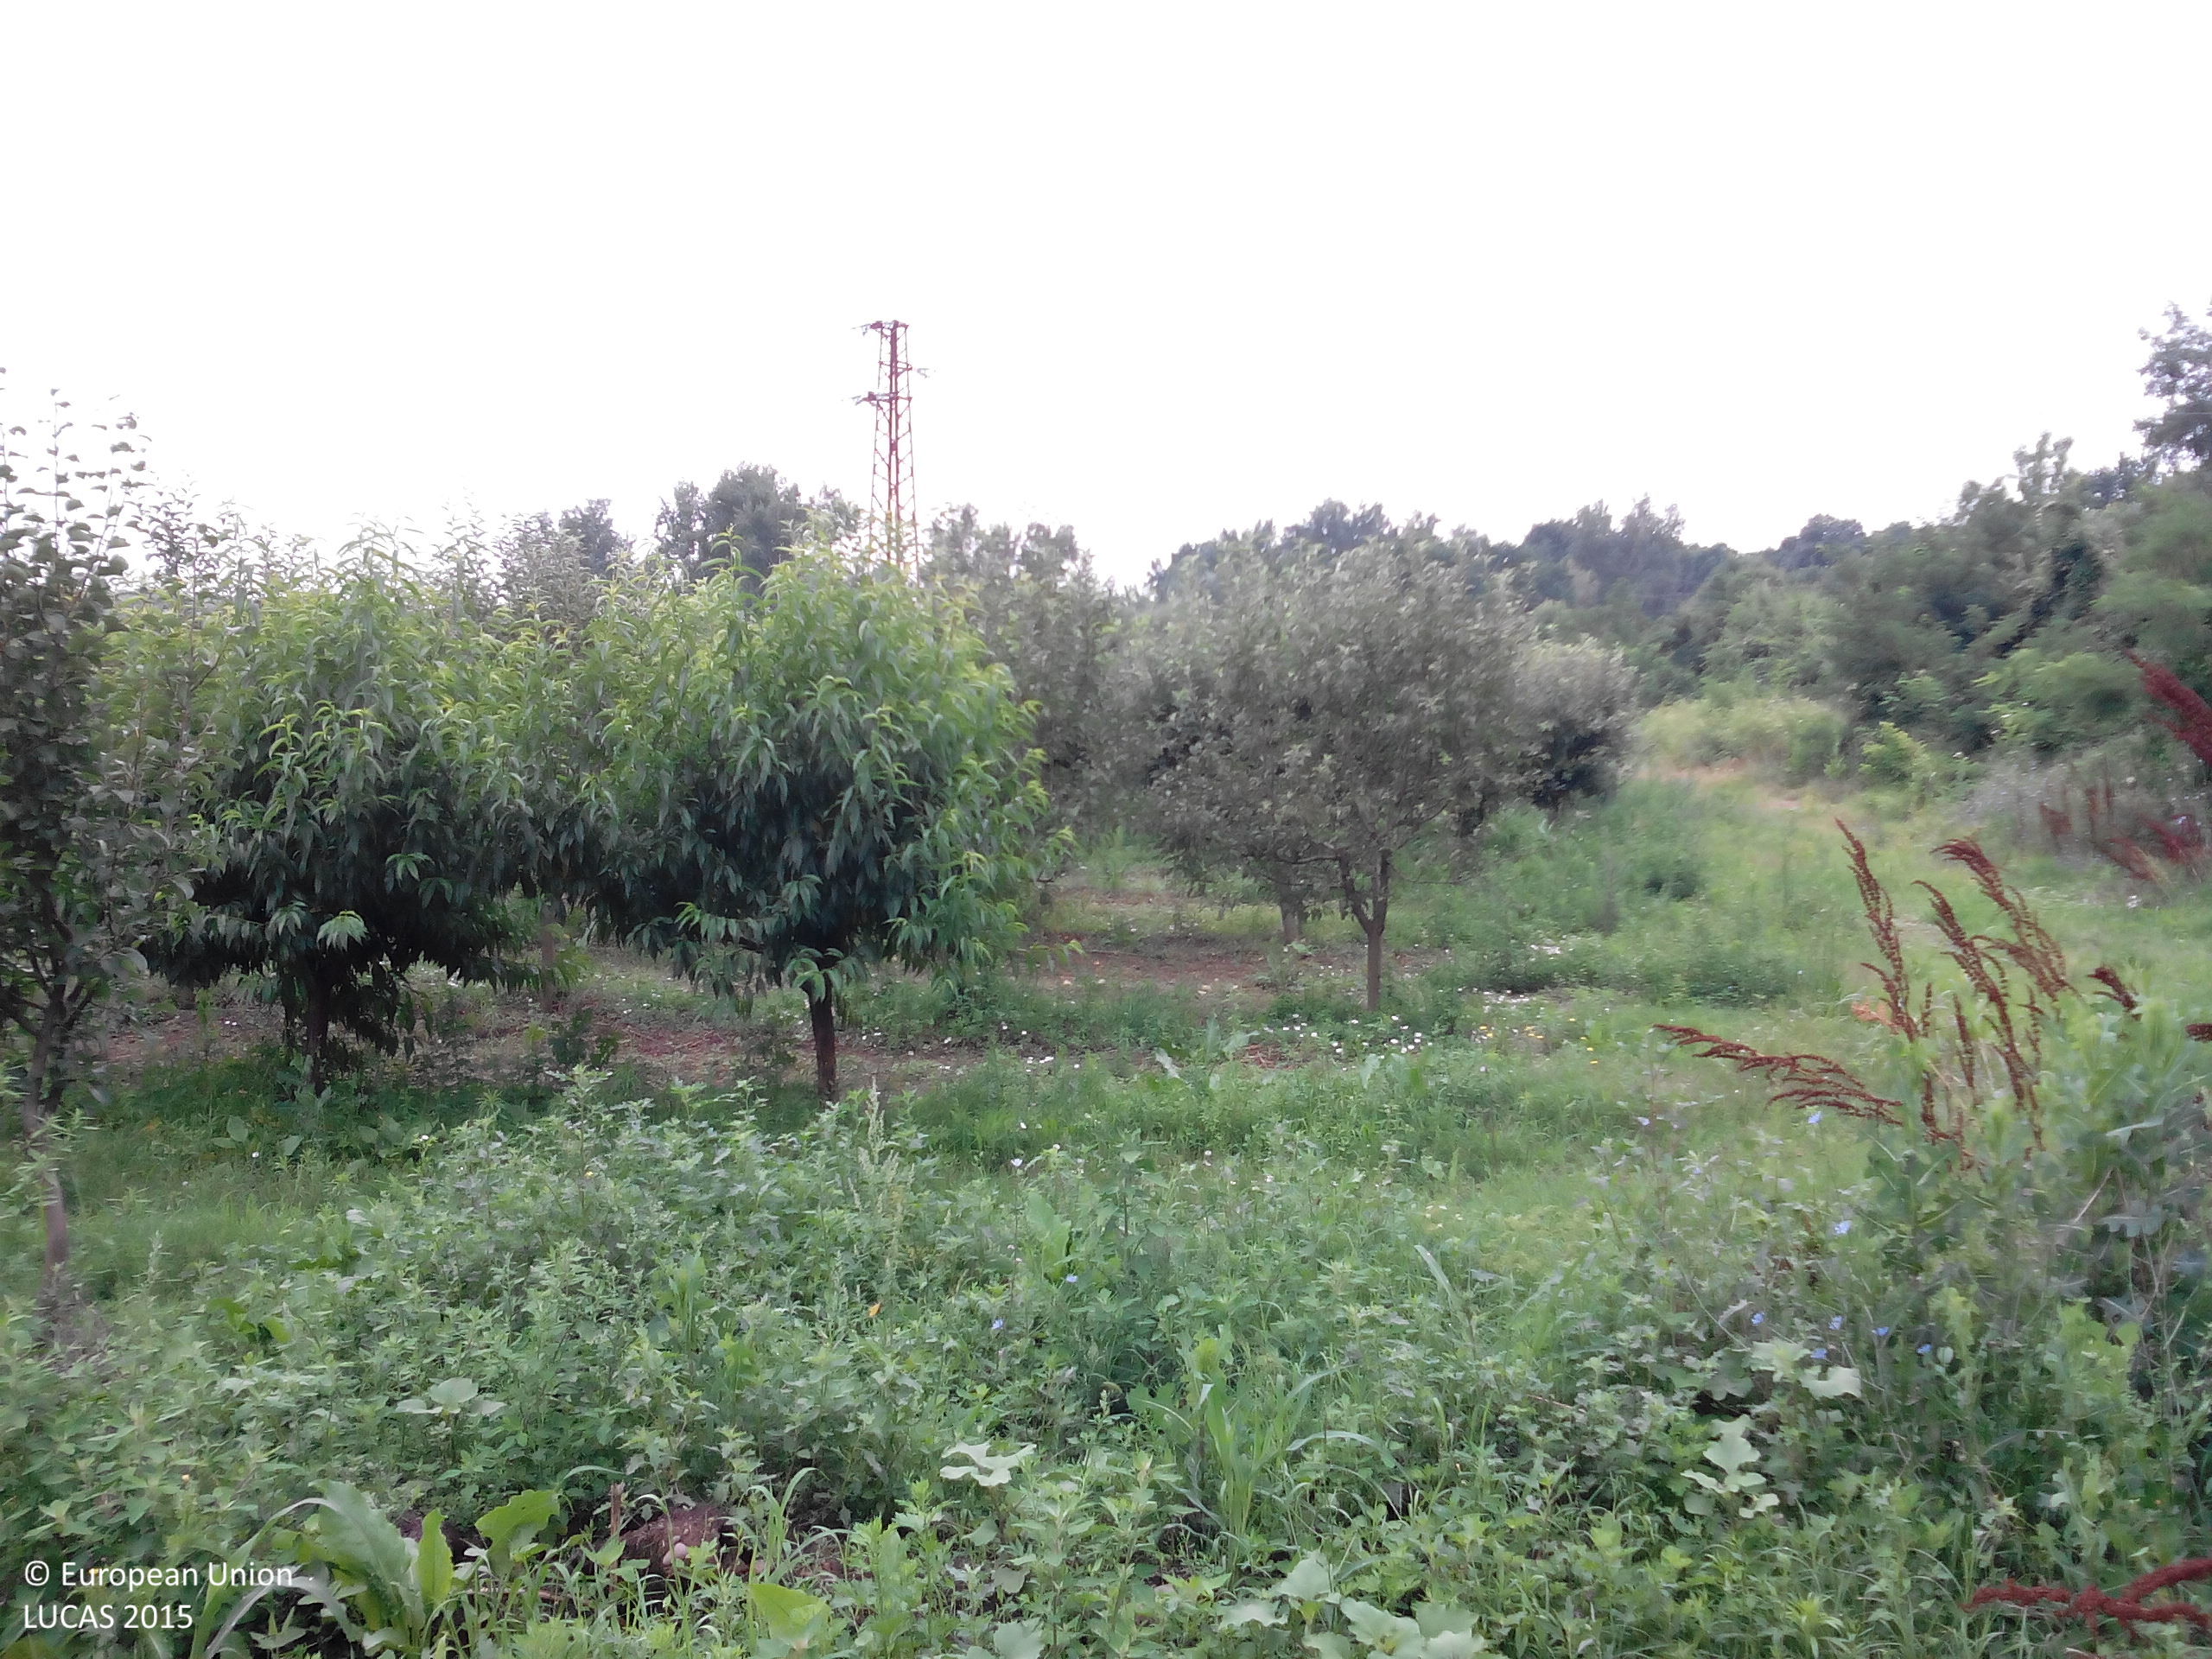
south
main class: Grassland
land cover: Spontaneously vegetated surfaces
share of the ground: > 75 %
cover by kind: herbaceous plants 95 %, shrubs 5 %
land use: Abandoned areas
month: July
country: BG
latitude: 43.4519
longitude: 24.2557
